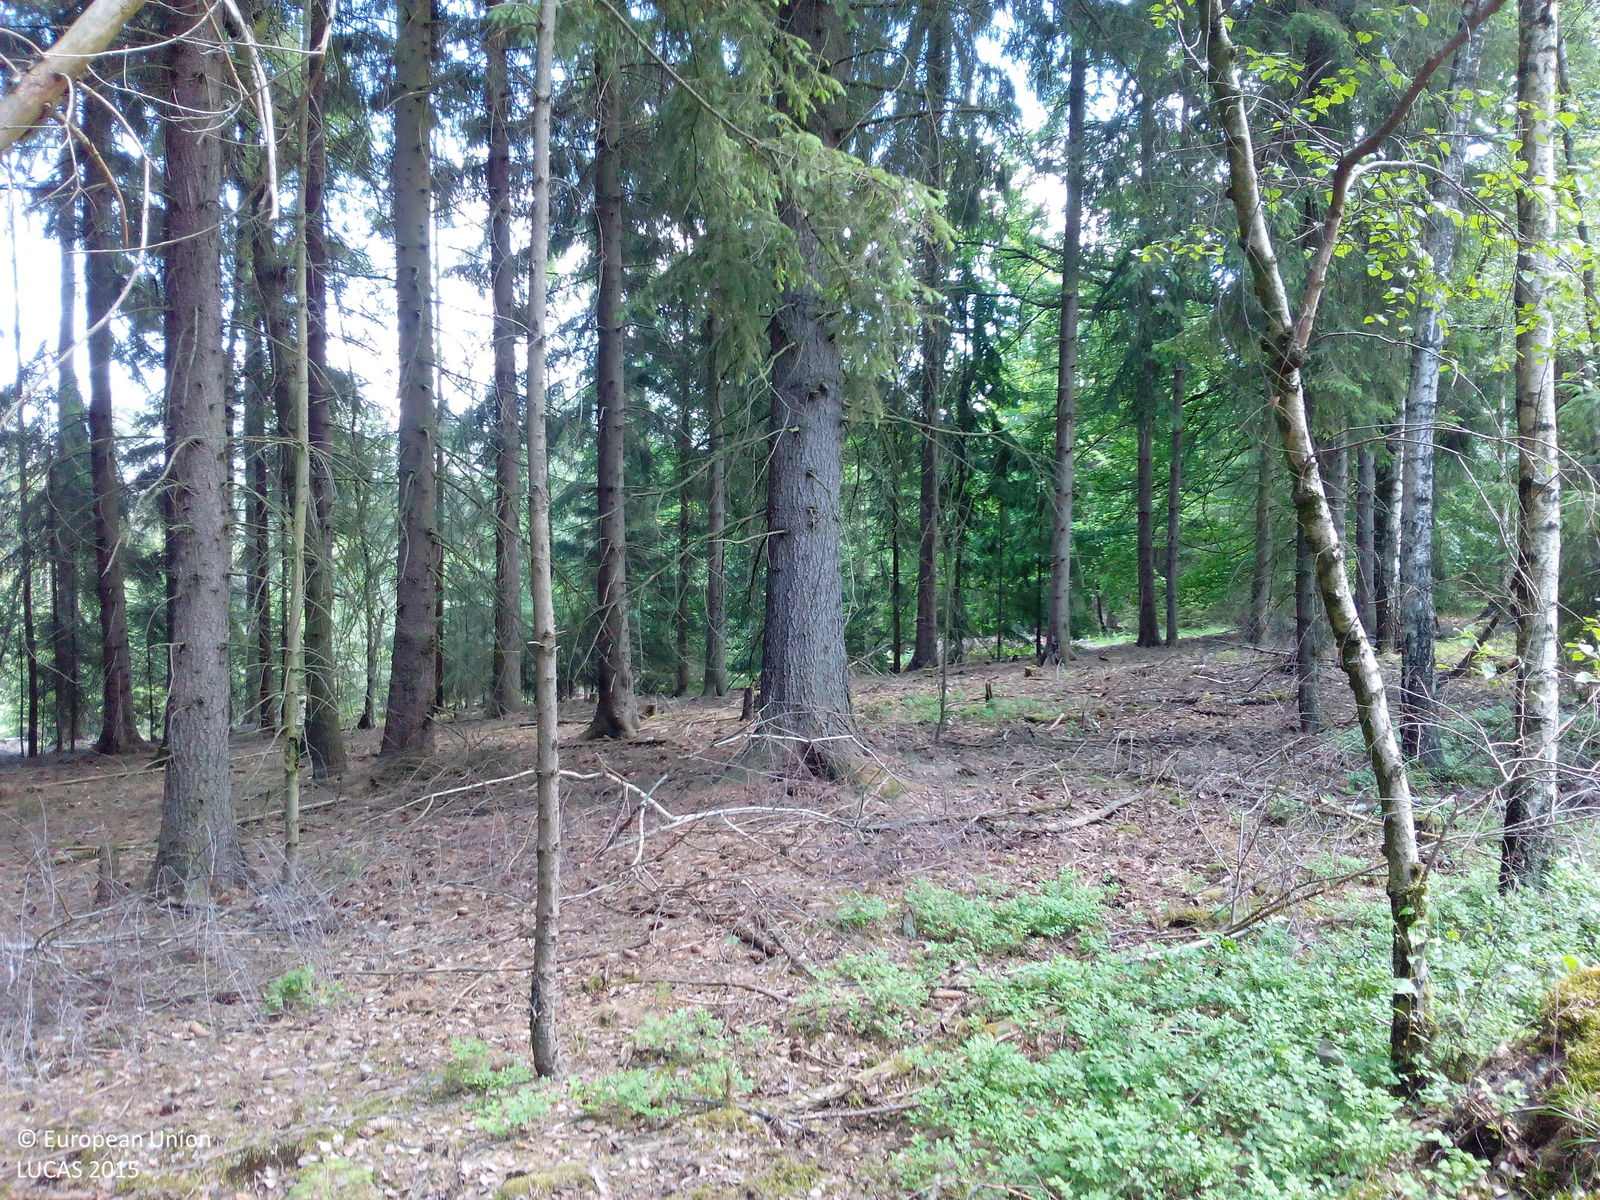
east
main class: Woodland
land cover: Spruce dominated coniferous woodland
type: hemiboreal forest and nemoral coniferous forest and mixed broadleaved-coniferous forest
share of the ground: > 75 %
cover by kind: coniferous forest trees 80 %, broadleaved forest trees 10 %, unconsolidated bare surface 10 %
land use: Forestry
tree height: > 5 m
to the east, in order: Spruce dominated coniferous woodland; Tracks; Spruce dominated coniferous woodland; Tracks; Spruce dominated coniferous woodland
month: June
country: DE
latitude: 50.7493
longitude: 11.5445
